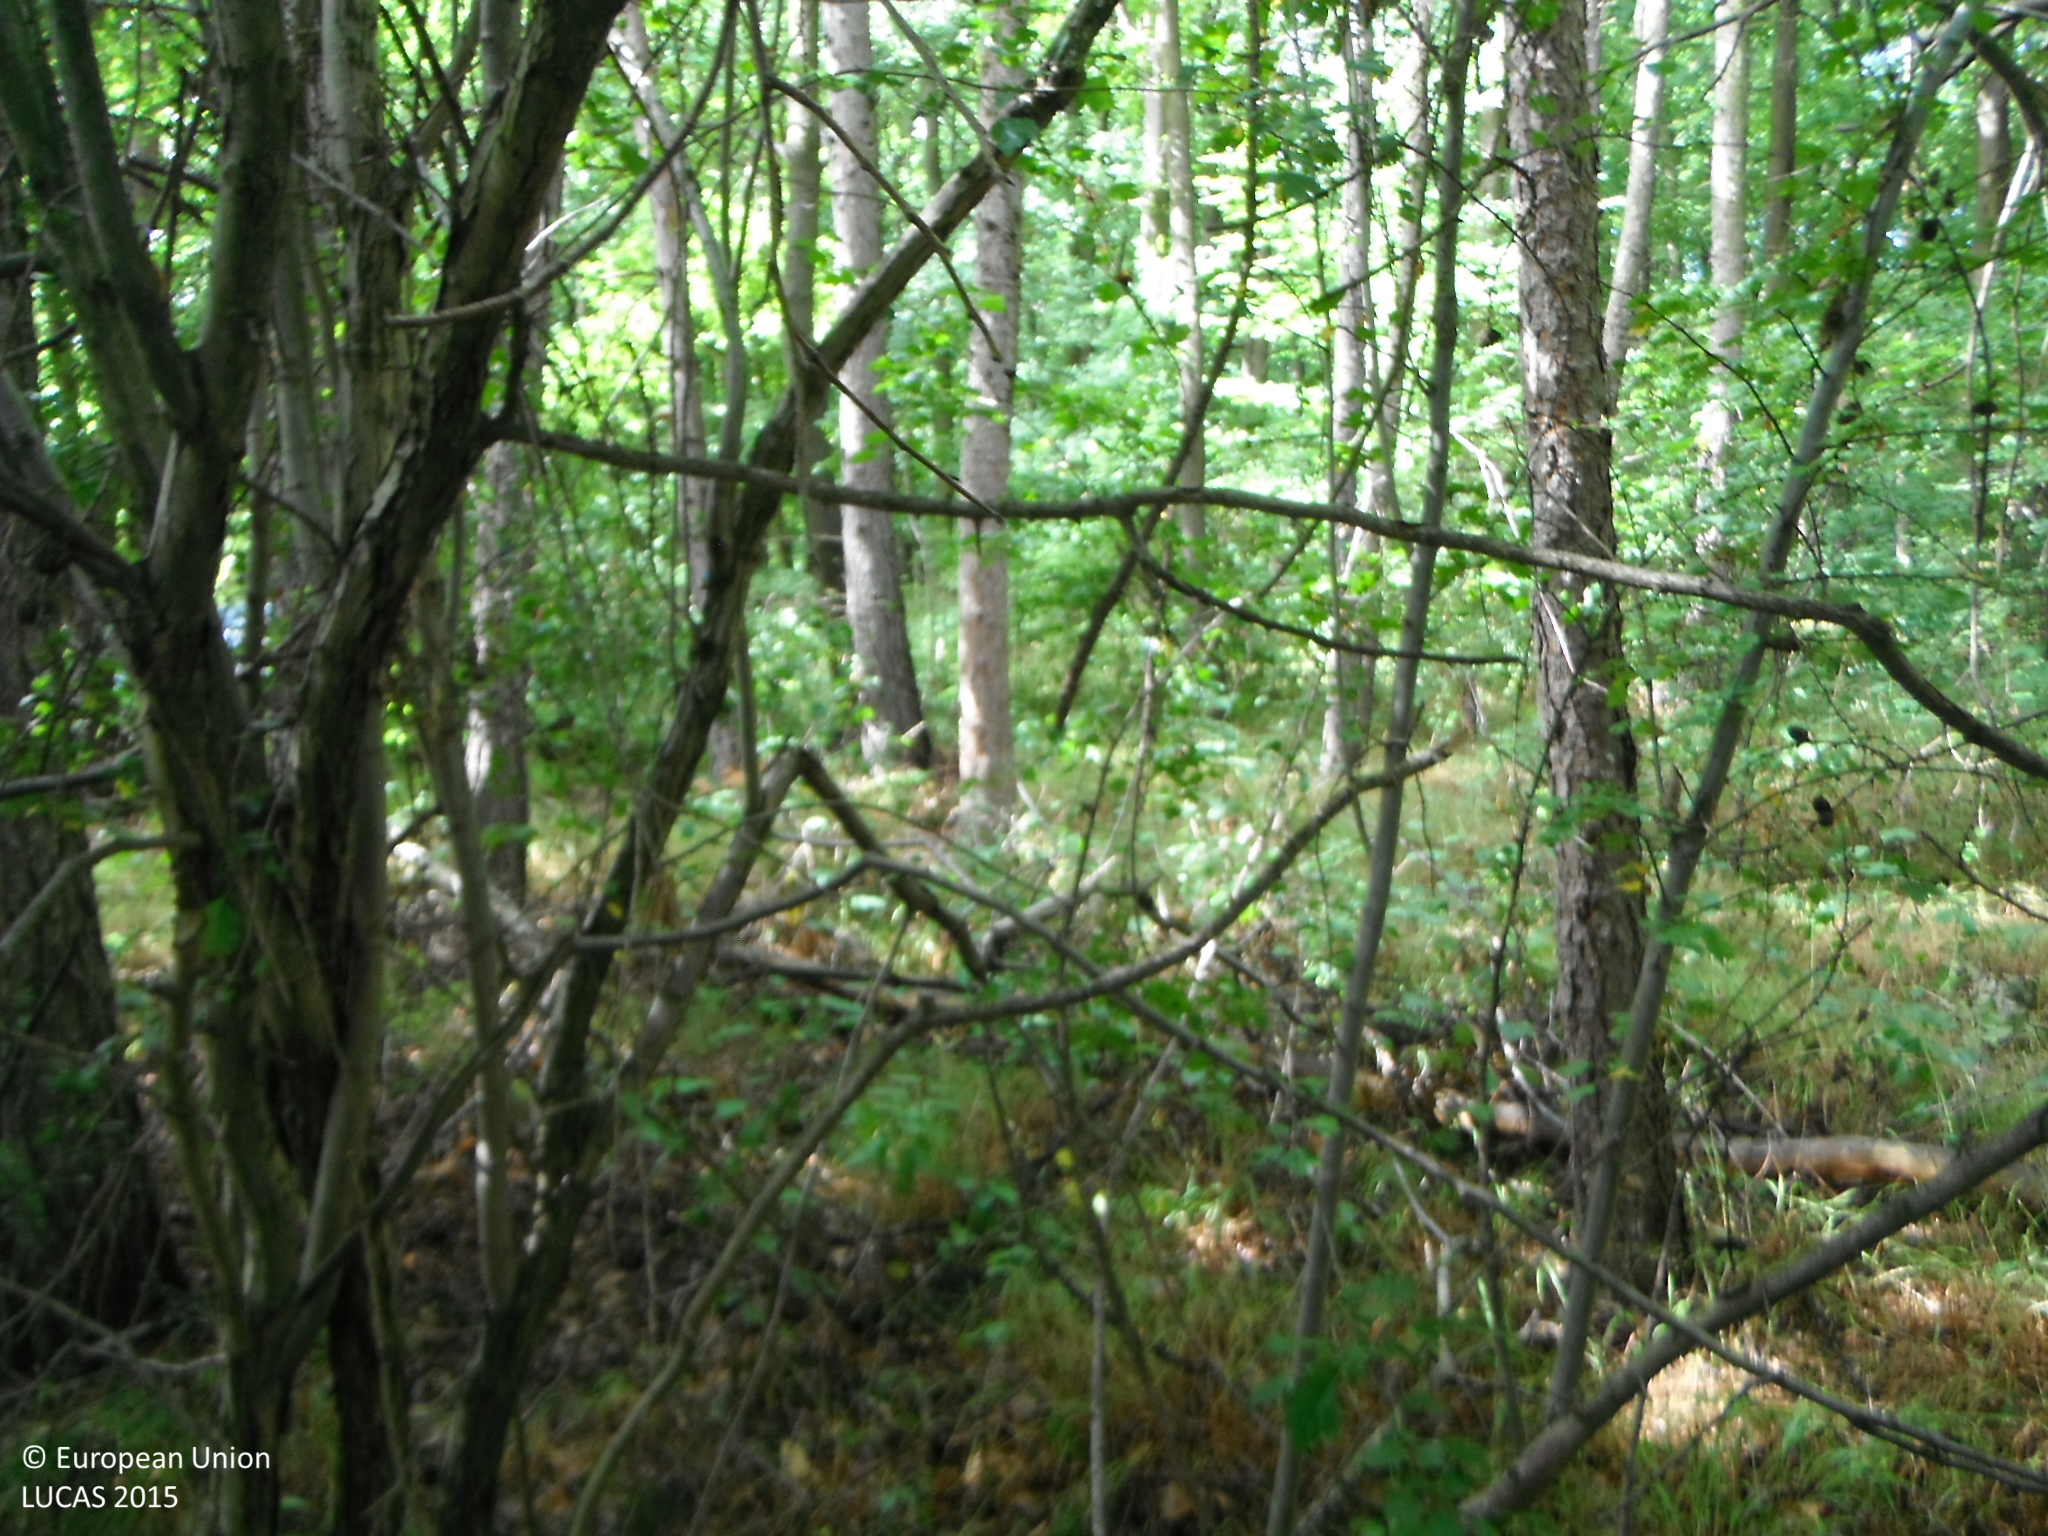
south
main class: Woodland
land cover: Other mixed woodland
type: hemiboreal forest and nemoral coniferous forest and mixed broadleaved-coniferous forest
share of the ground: > 75 %
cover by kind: coniferous forest trees 60 %, broadleaved forest trees 40 %
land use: Forestry
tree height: > 5 m
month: July
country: SK
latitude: 48.7582
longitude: 18.3276
